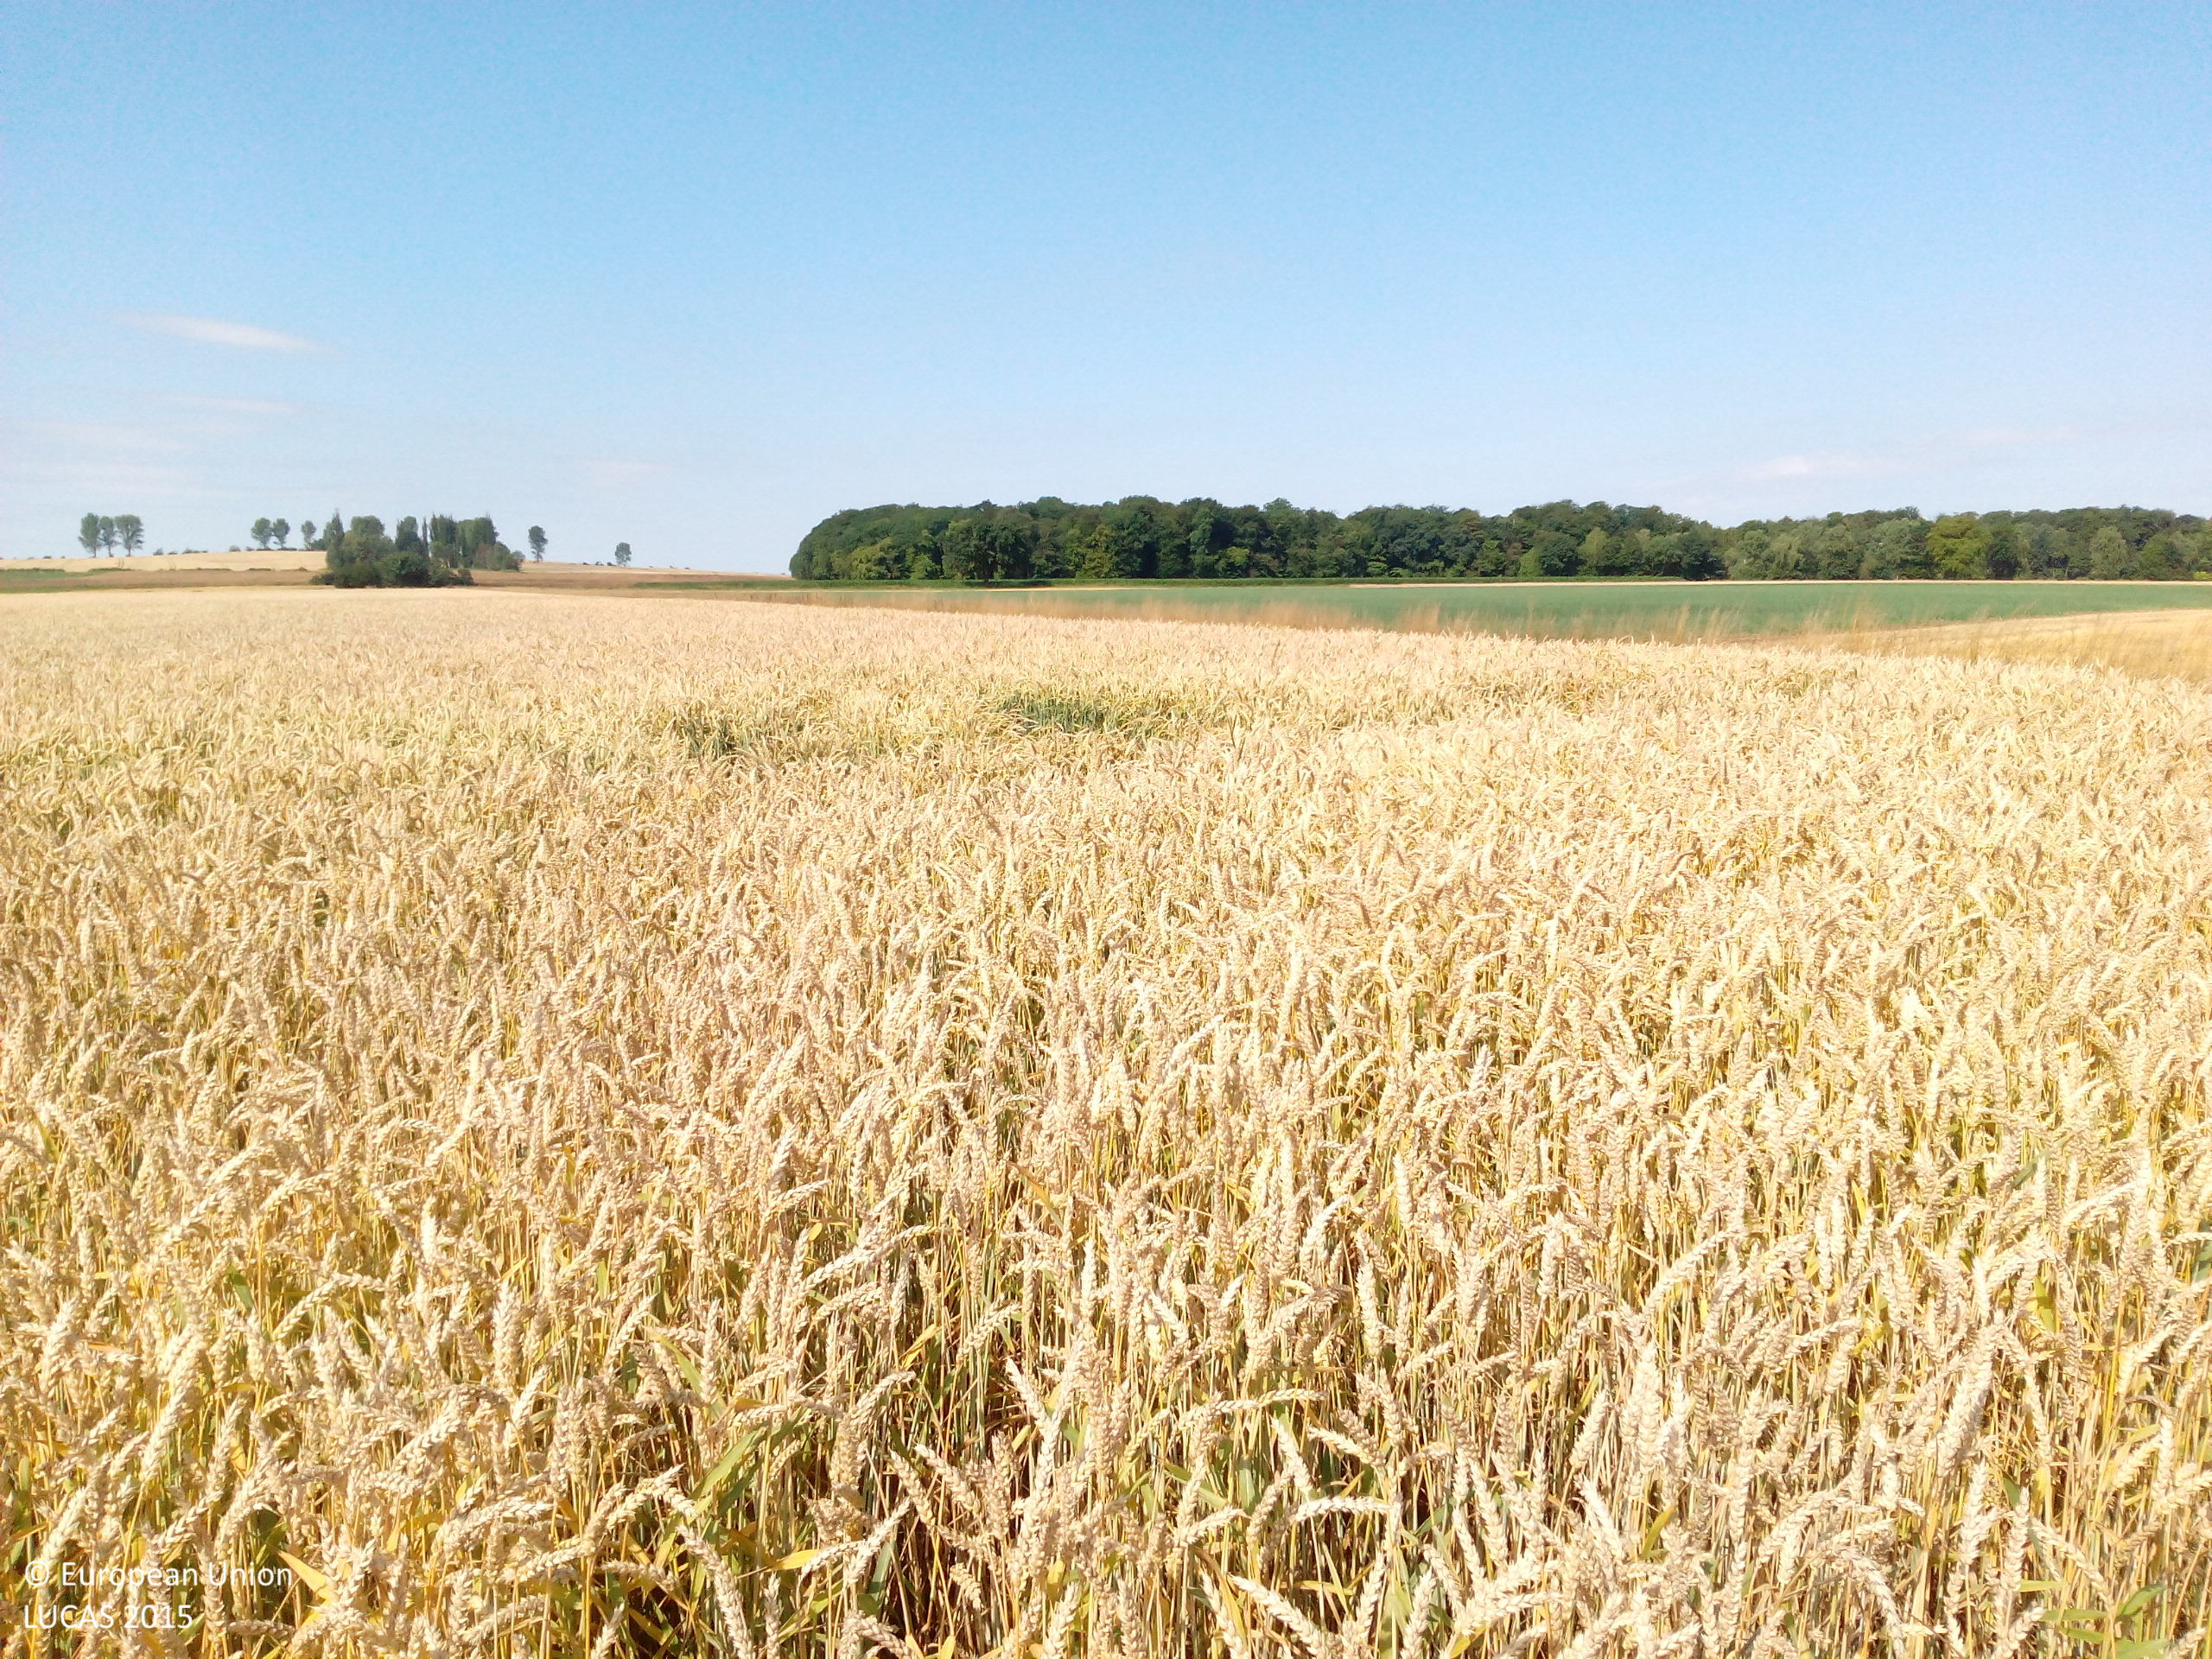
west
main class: Cropland
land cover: Common wheat
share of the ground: > 75 %
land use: Agriculture (excluding fallow land and kitchen gardens)
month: July
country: DE
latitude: 52.2693
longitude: 10.2783
